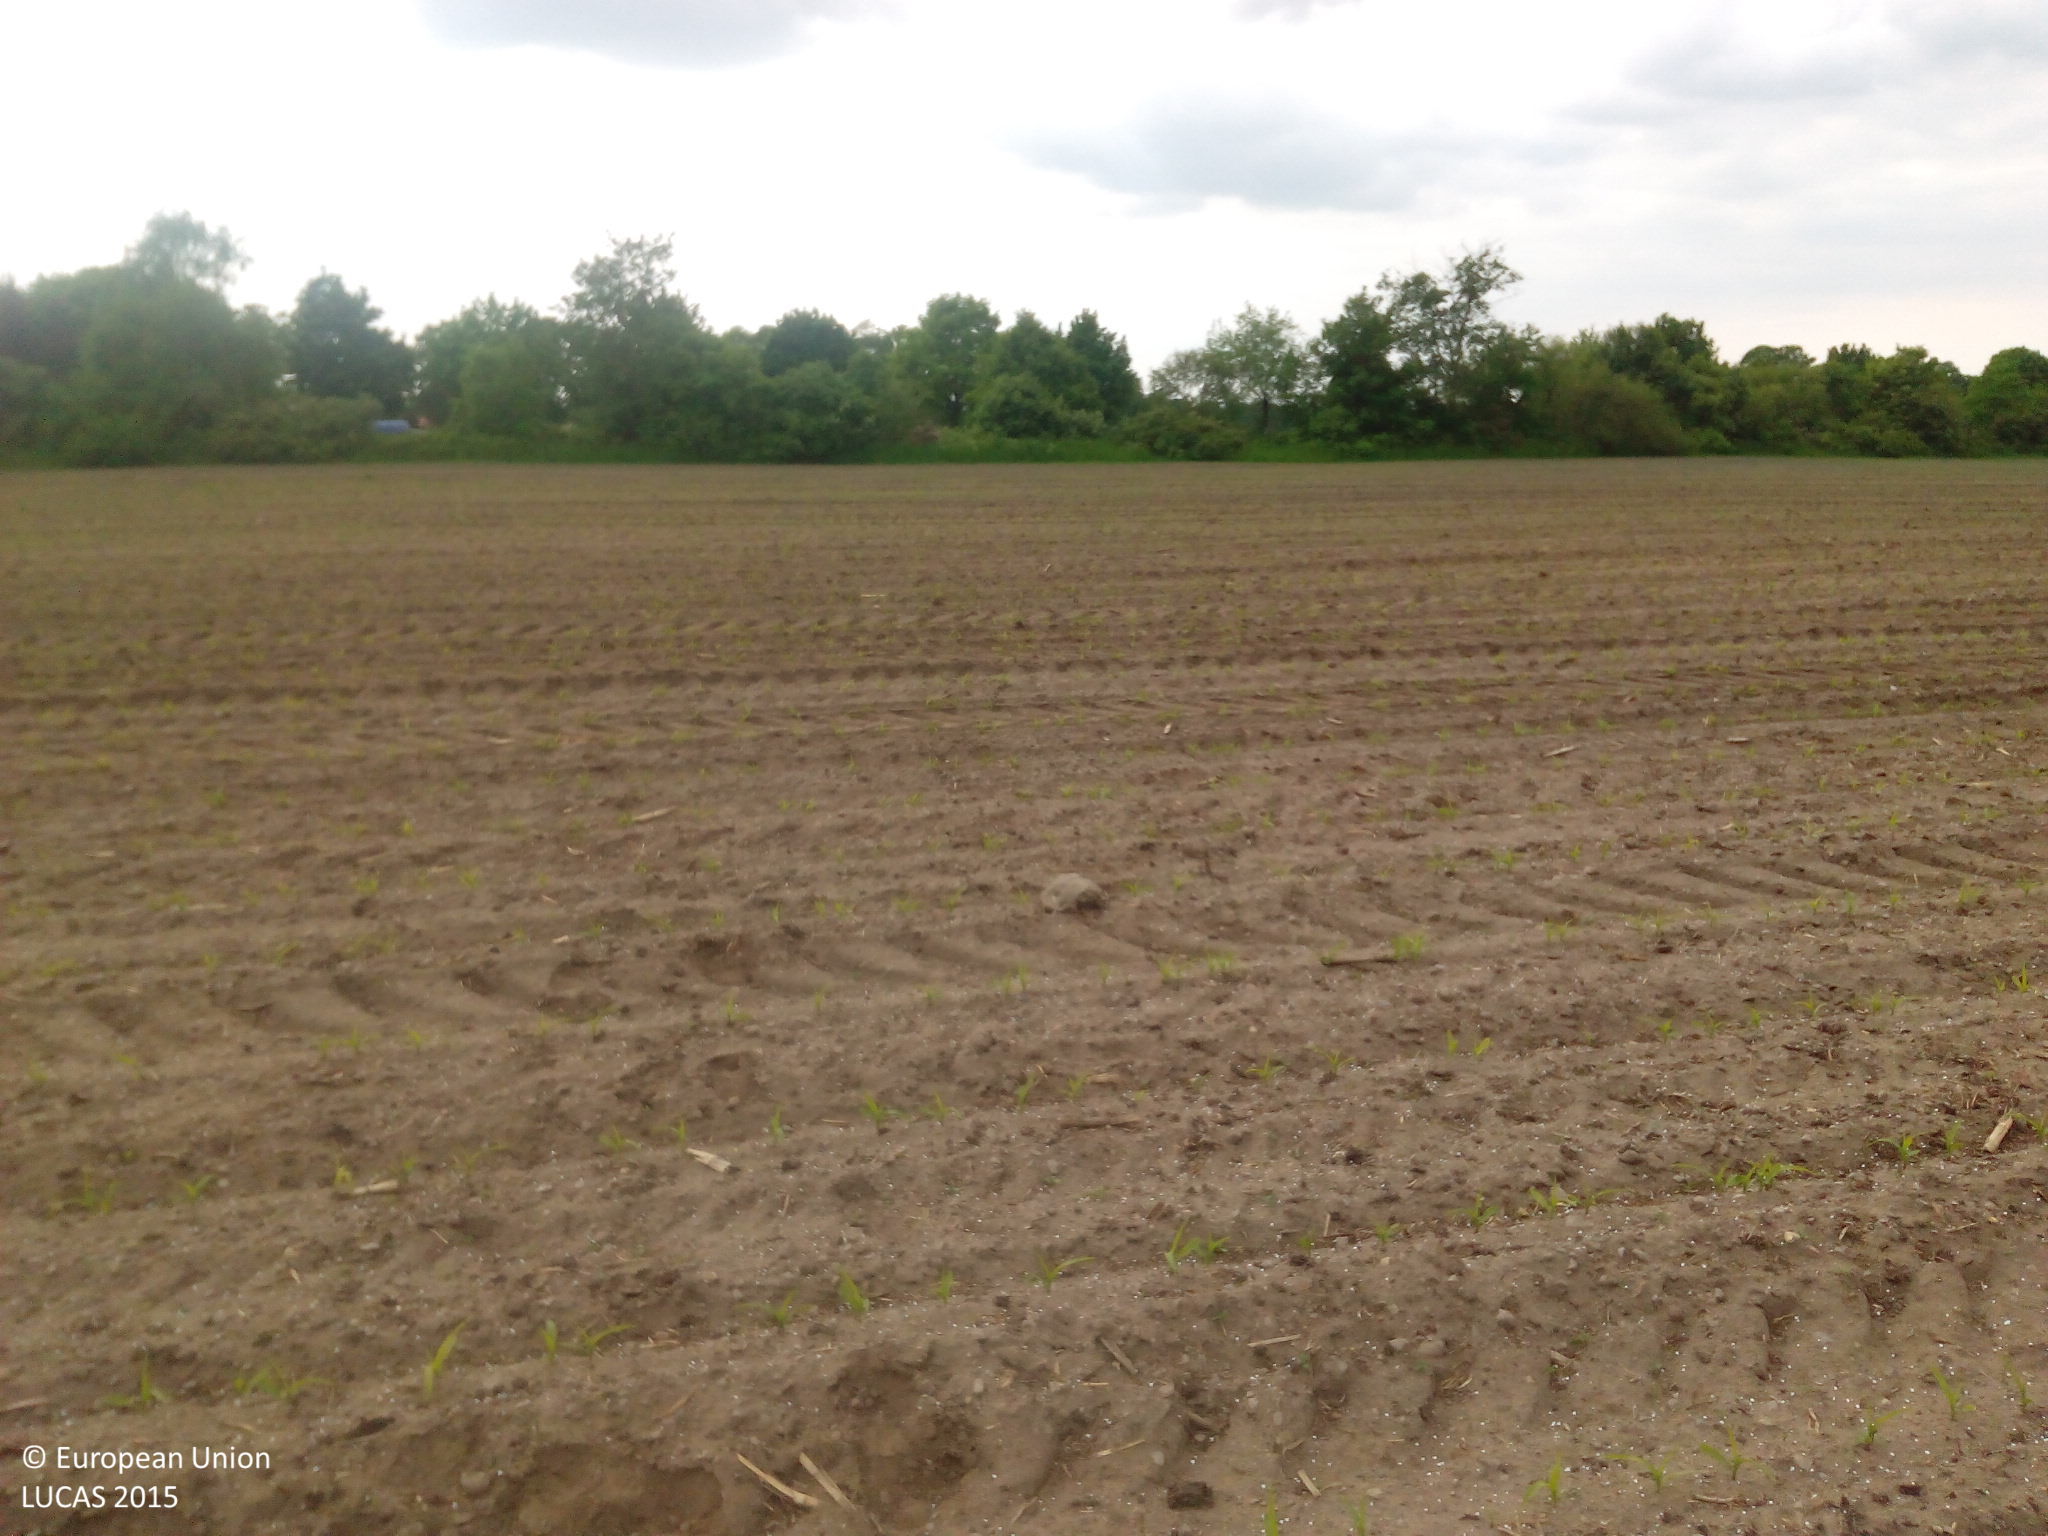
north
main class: Cropland
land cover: Maize
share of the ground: < 10 %
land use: Agriculture (excluding fallow land and kitchen gardens)
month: May
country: DE
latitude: 53.4467
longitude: 11.4900
